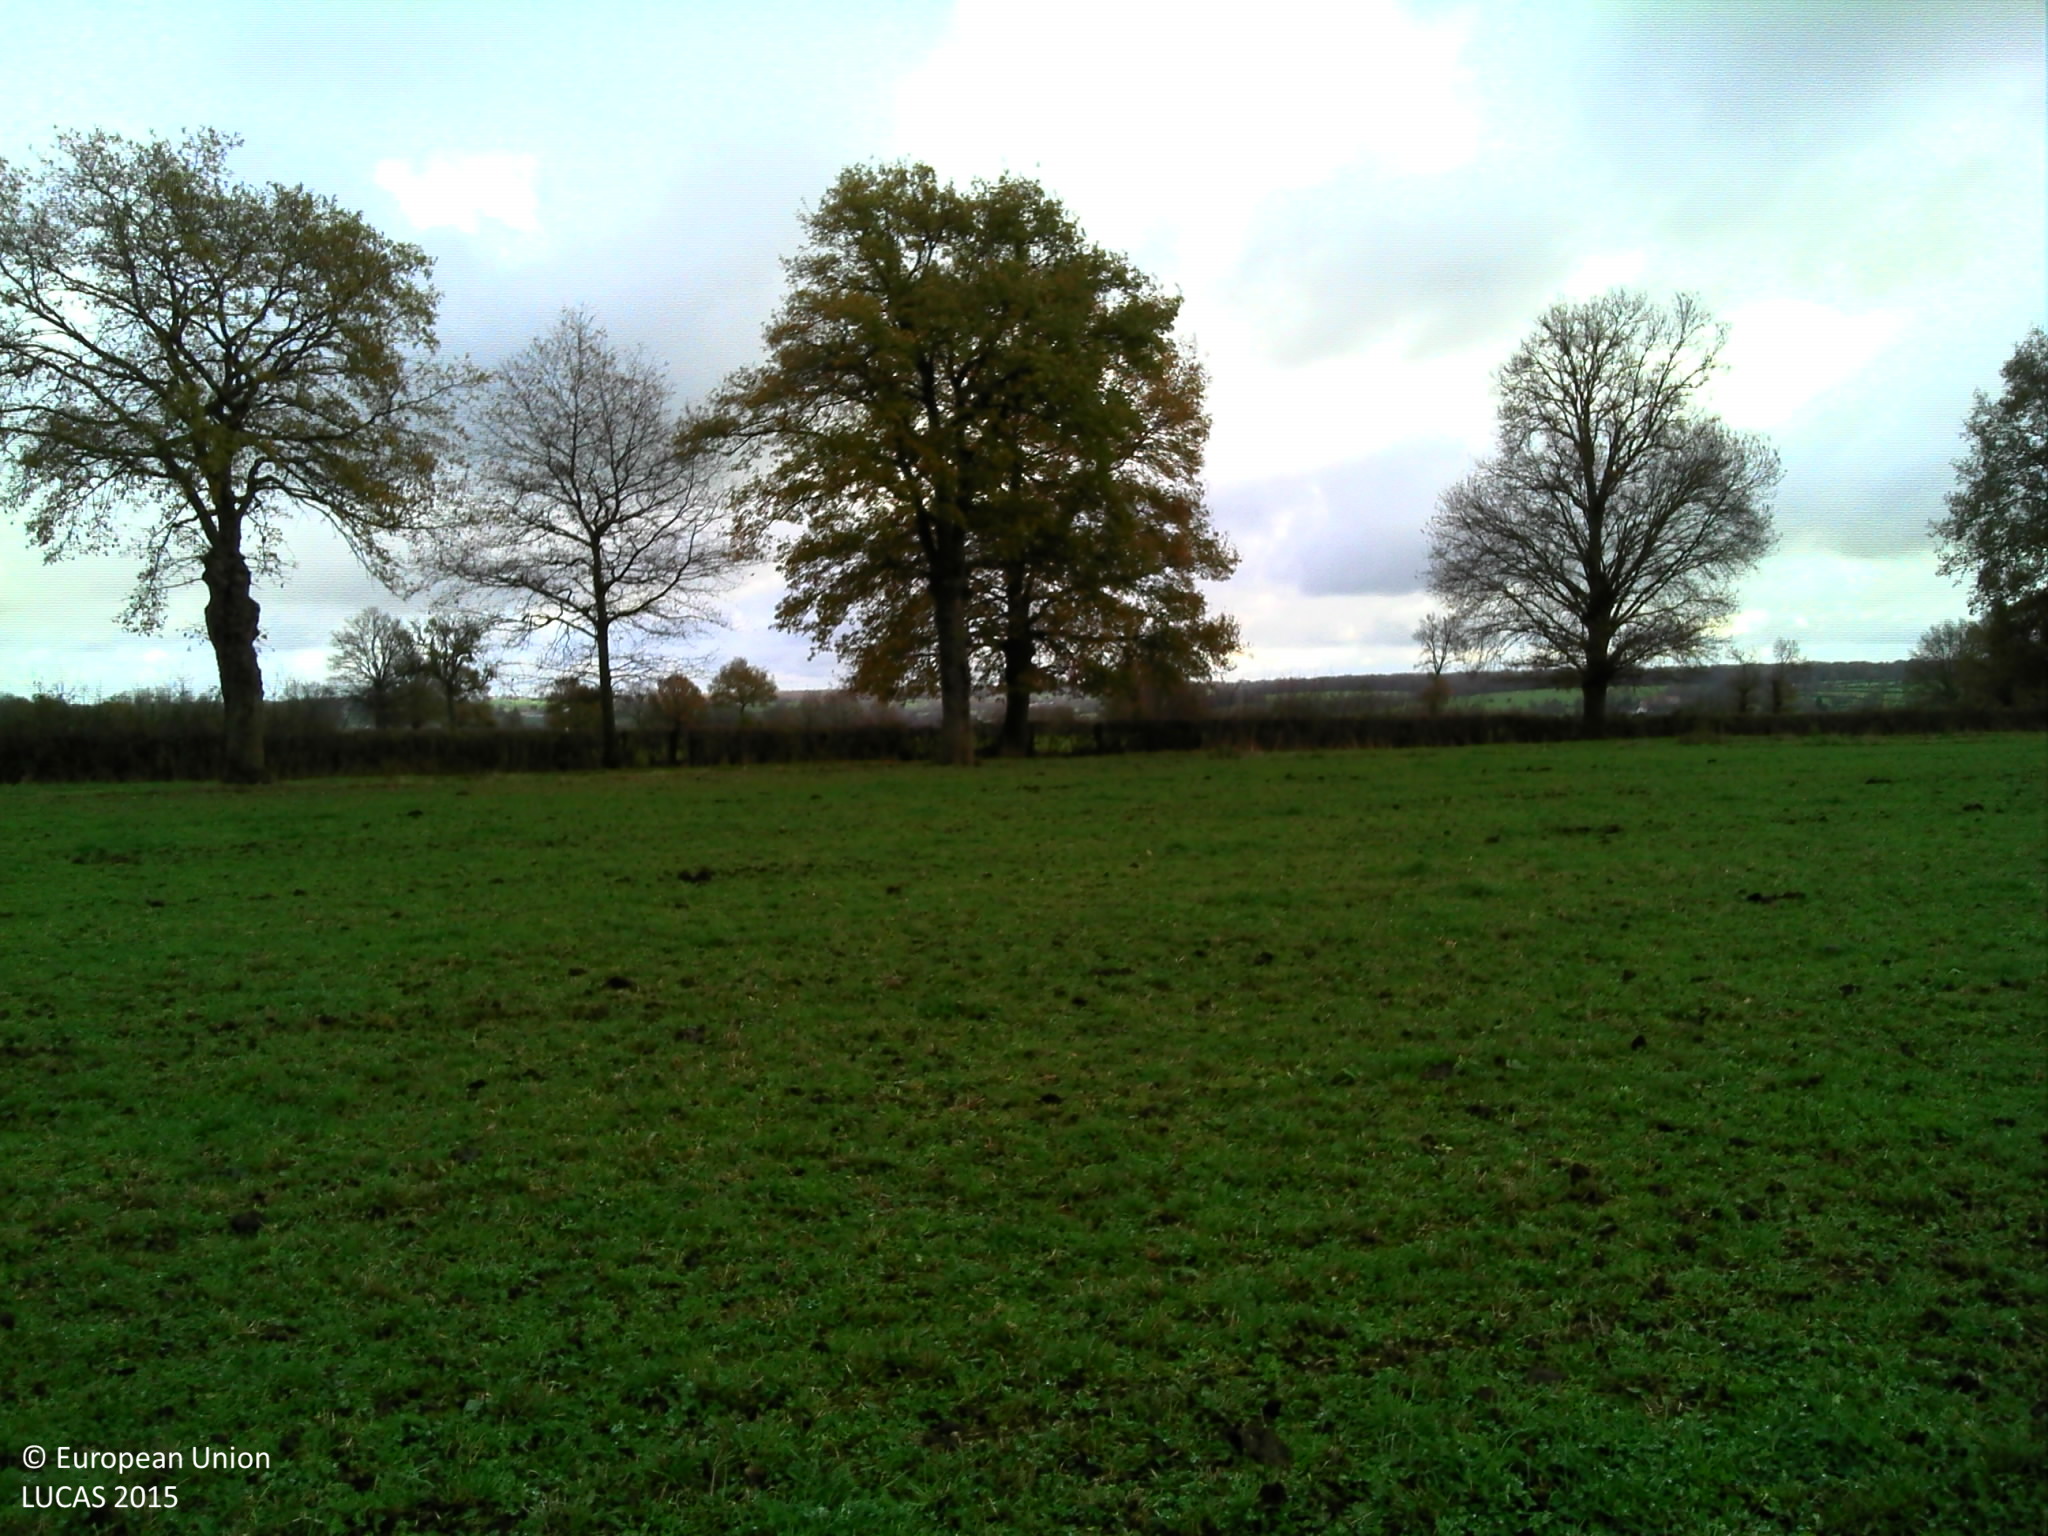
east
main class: Grassland
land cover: Grassland without tree/shrub cover
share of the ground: > 75 %
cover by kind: herbaceous plants 100 %
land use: Agriculture (excluding fallow land and kitchen gardens)
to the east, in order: Grassland without tree/shrub cover; Lines of trees; Ditches and canals; Grass margins; Tracks; Grass margins; Lines of trees; Managed hedges; Fences; Grassland without tree/shrub cover
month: August
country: FR
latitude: 46.4310
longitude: 3.6096
